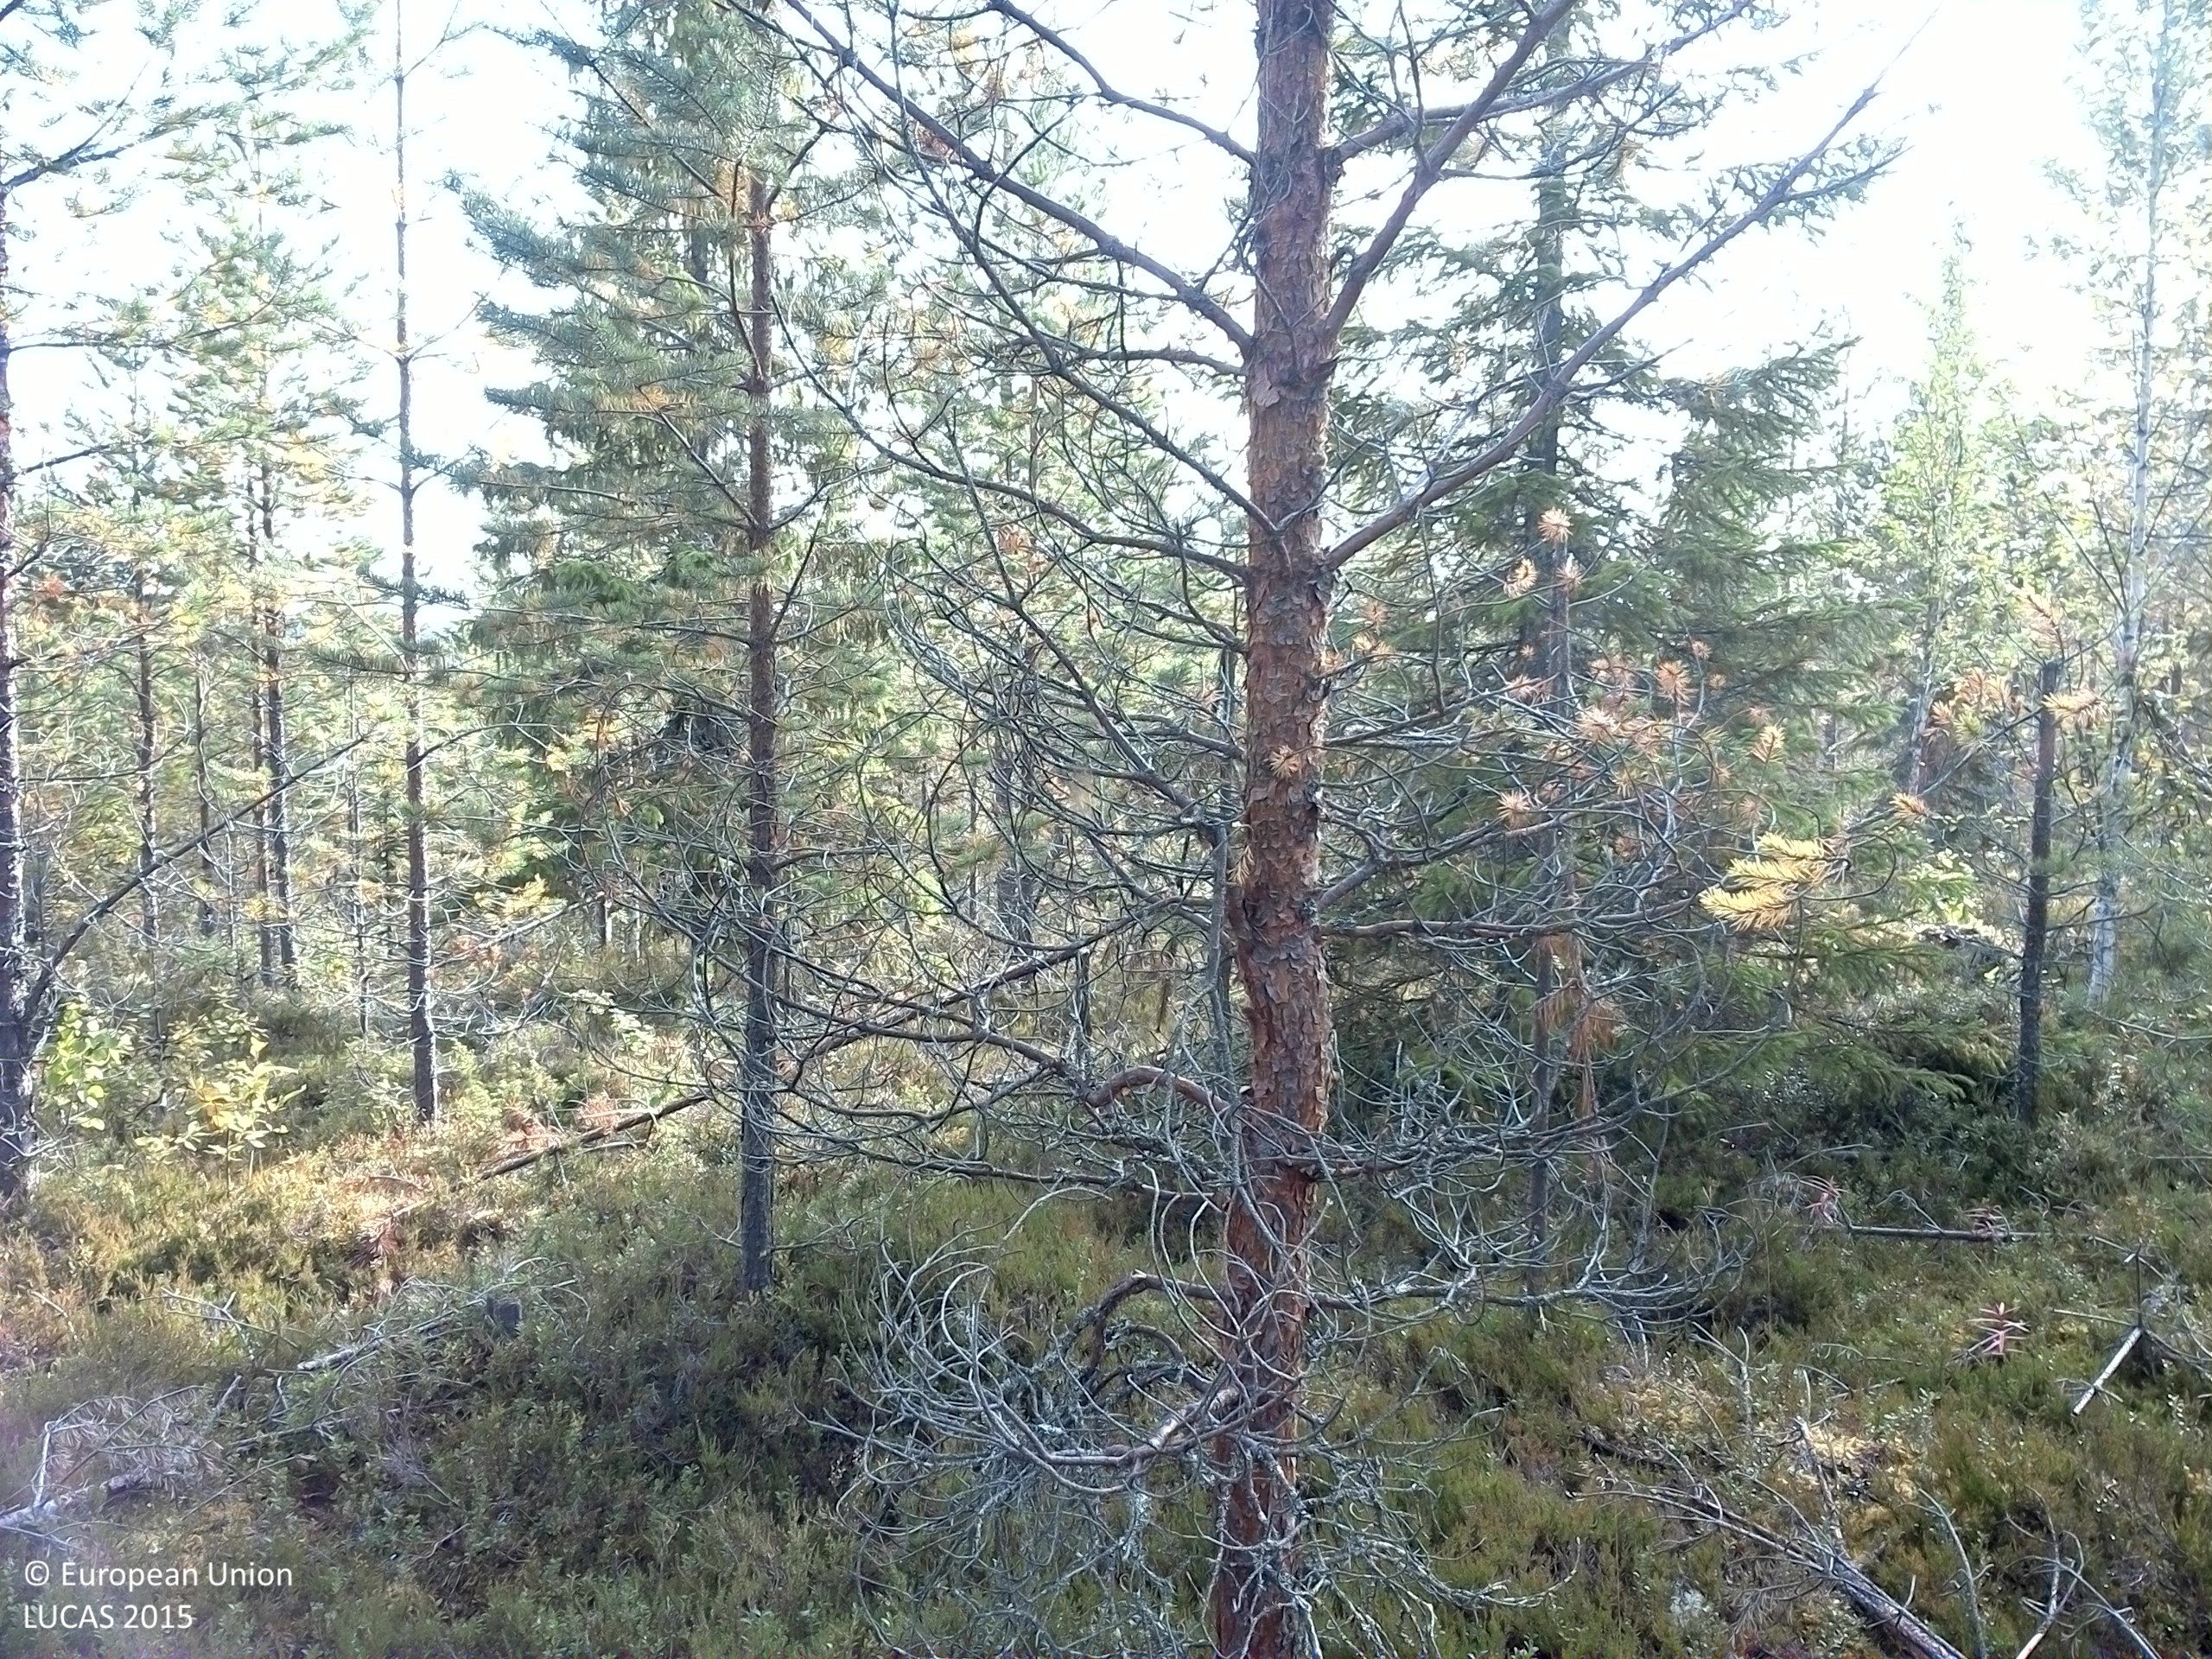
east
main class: Woodland
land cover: Pine dominated coniferous woodland
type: boreal forest
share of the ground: 25 - 50 %
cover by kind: shrubs 45 %, coniferous forest trees 35 %, lichens and mosses 15 %, broadleaved forest trees 5 %
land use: Forestry
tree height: > 5 m
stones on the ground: 10 - 25 %
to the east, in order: Pine dominated coniferous woodland; Inland marshes
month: September
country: SE
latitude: 63.9901
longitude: 16.5725
